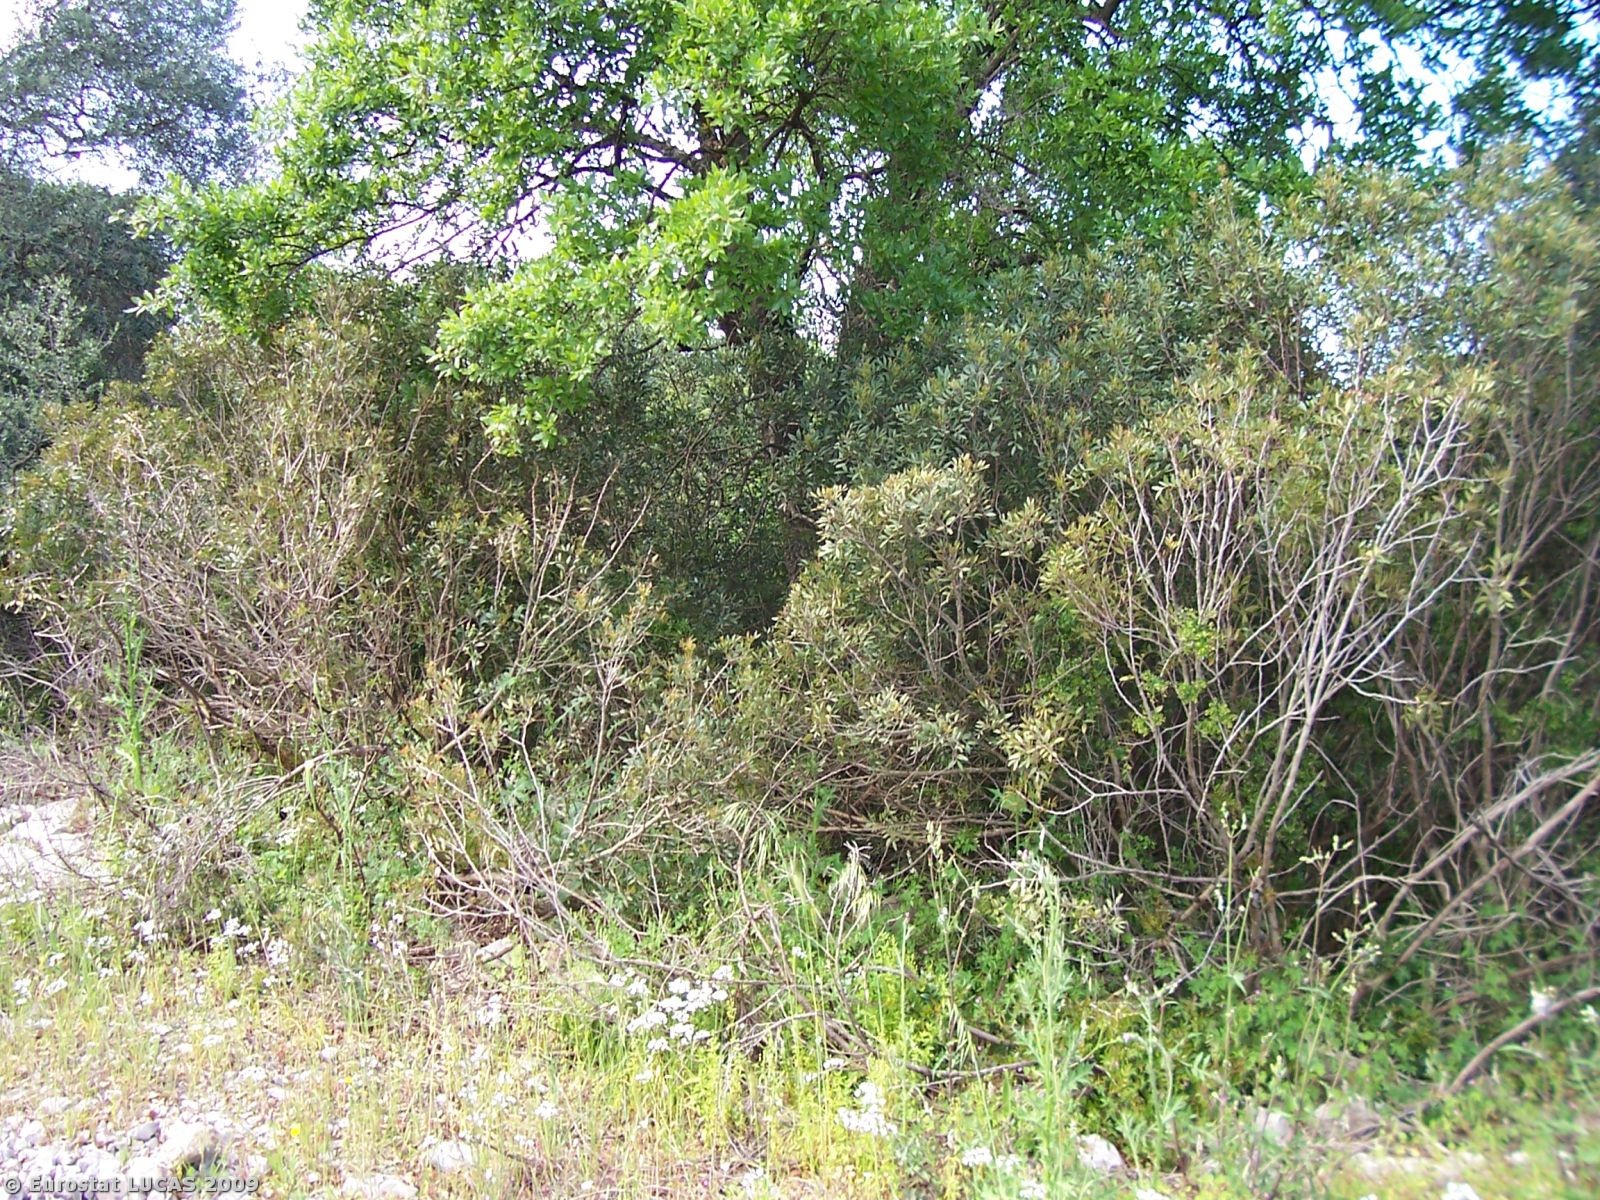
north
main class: Shrubland
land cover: Shrubland without tree cover
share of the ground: > 75 %
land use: Nature reserves
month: May
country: IT
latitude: 40.5911
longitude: 16.8413
